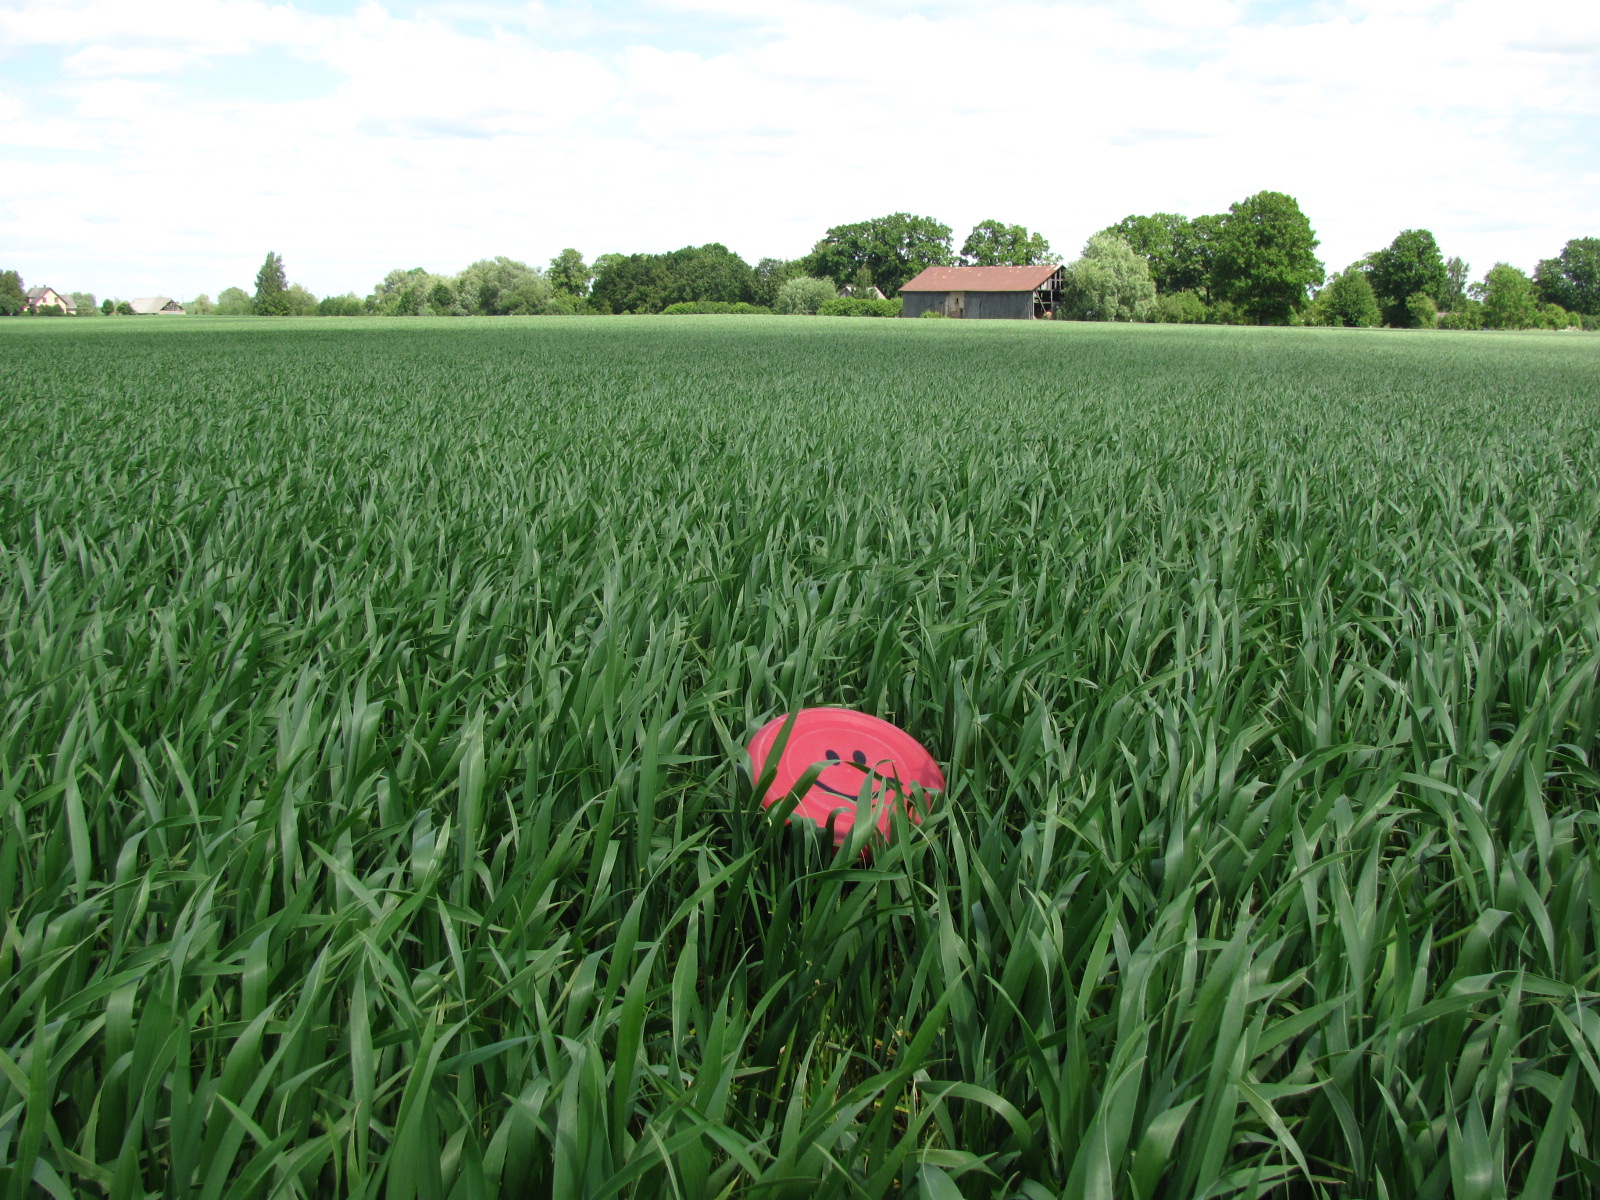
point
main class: Cropland
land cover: Common wheat
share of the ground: > 75 %
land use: Agriculture (excluding fallow land and kitchen gardens)
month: June
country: LV
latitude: 56.2718
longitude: 24.1877
